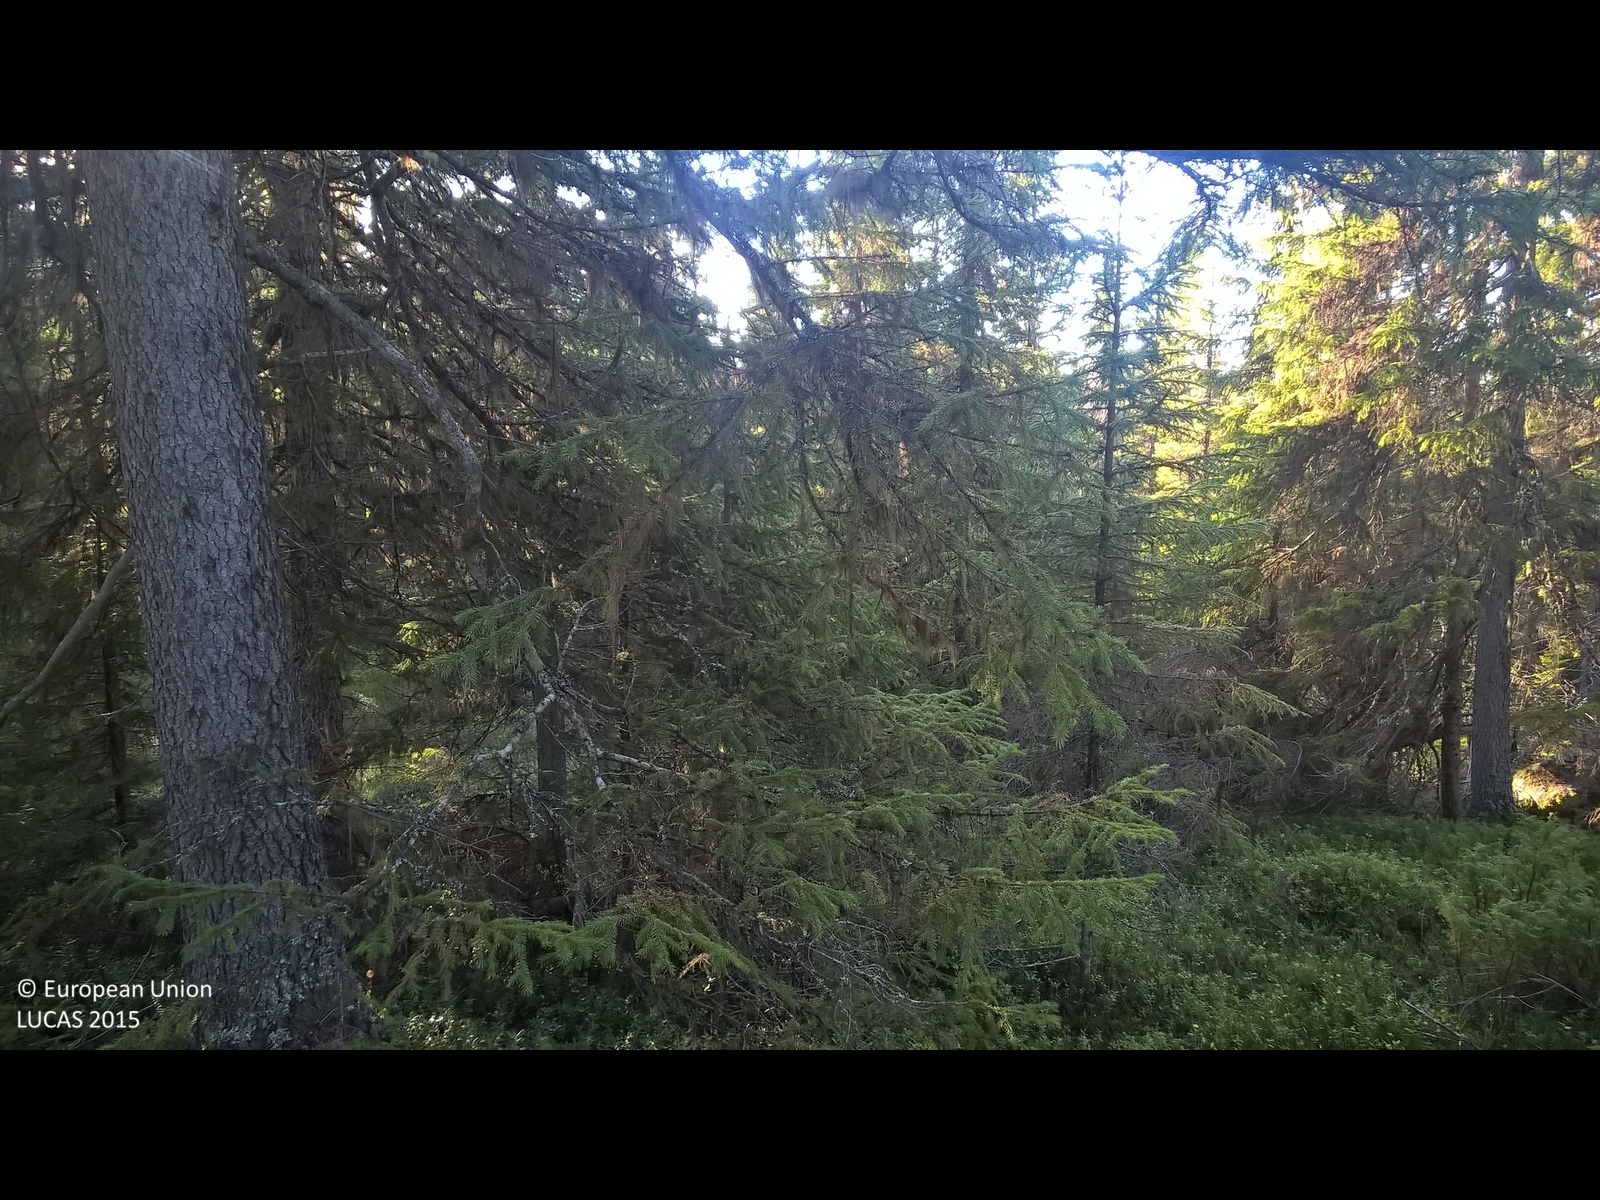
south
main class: Woodland
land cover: Spruce dominated coniferous woodland
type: boreal forest
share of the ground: 50 - 75 %
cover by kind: coniferous forest trees 70 %, lichens and mosses 30 %
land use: Forestry
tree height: > 5 m
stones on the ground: < 10 %
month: October
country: SE
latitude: 63.3285
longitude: 13.5563
